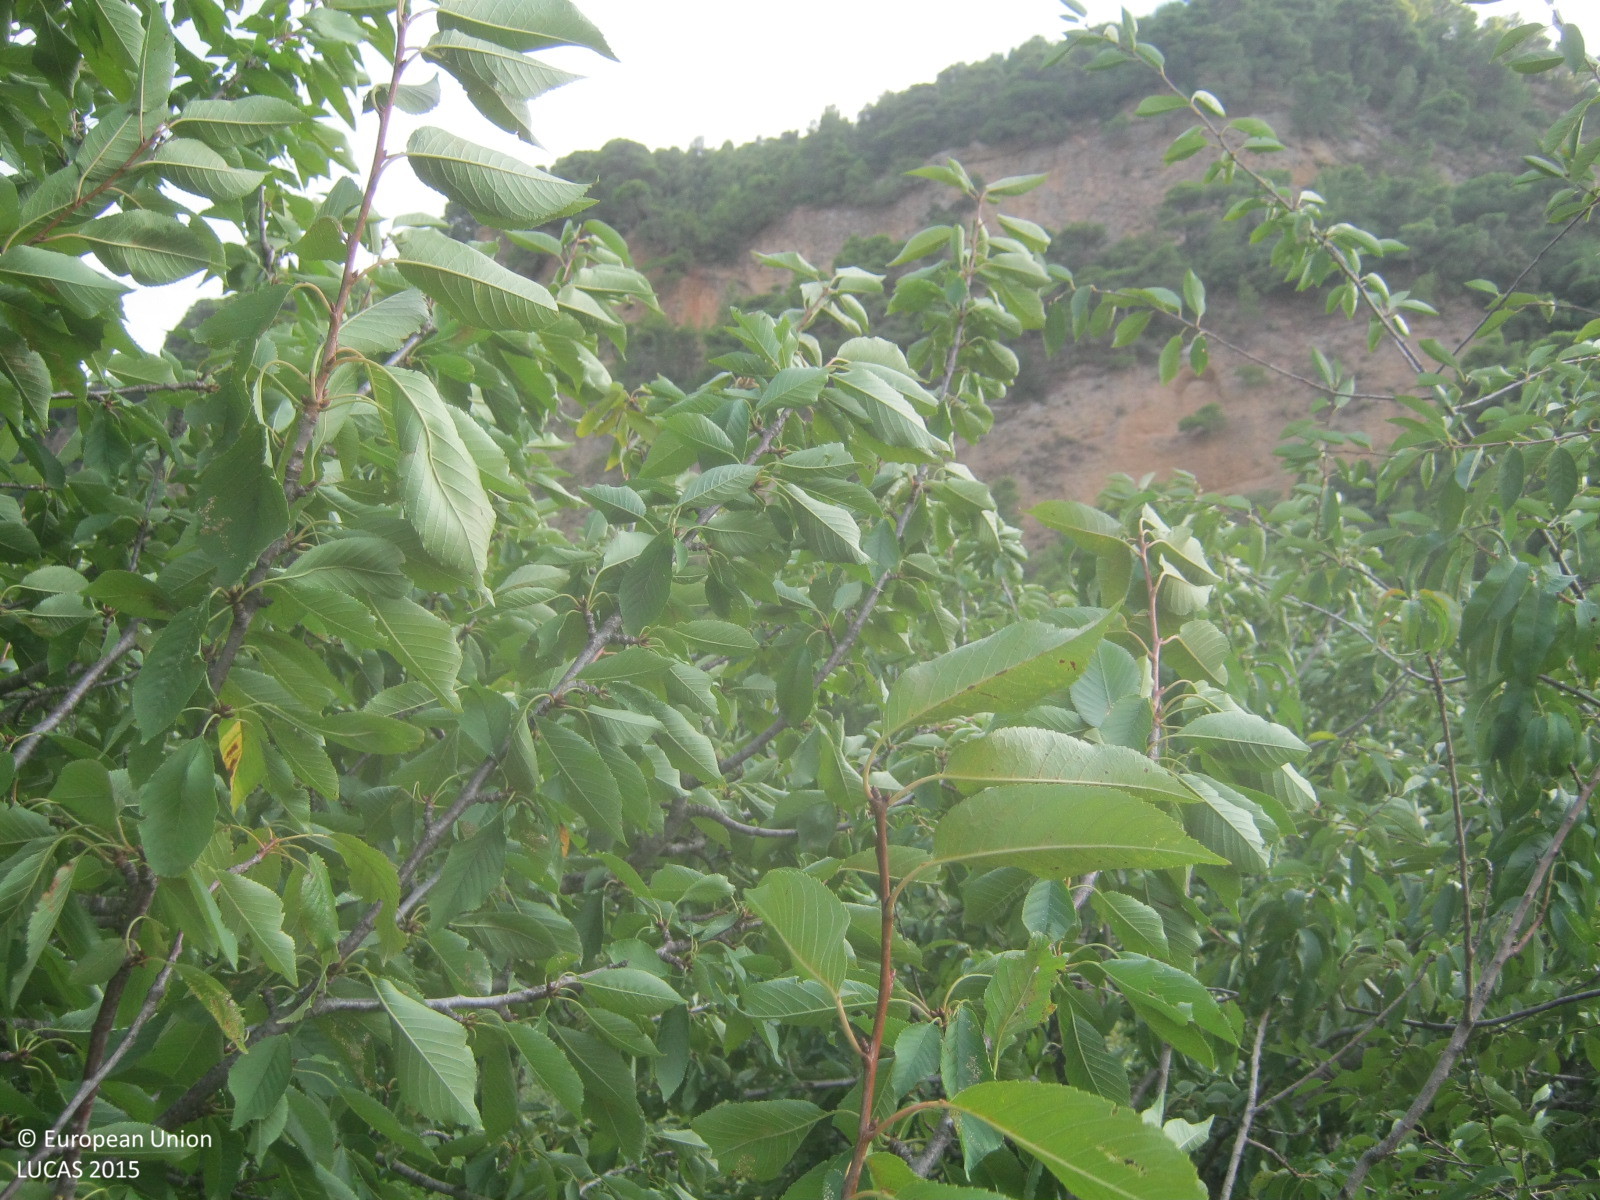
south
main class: Cropland
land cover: Cherry fruit
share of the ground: 50 - 75 %
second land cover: Spontaneously vegetated surfaces
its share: > 75 %
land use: Agriculture (excluding fallow land and kitchen gardens)
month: September
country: GR
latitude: 38.2703
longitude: 21.8213
